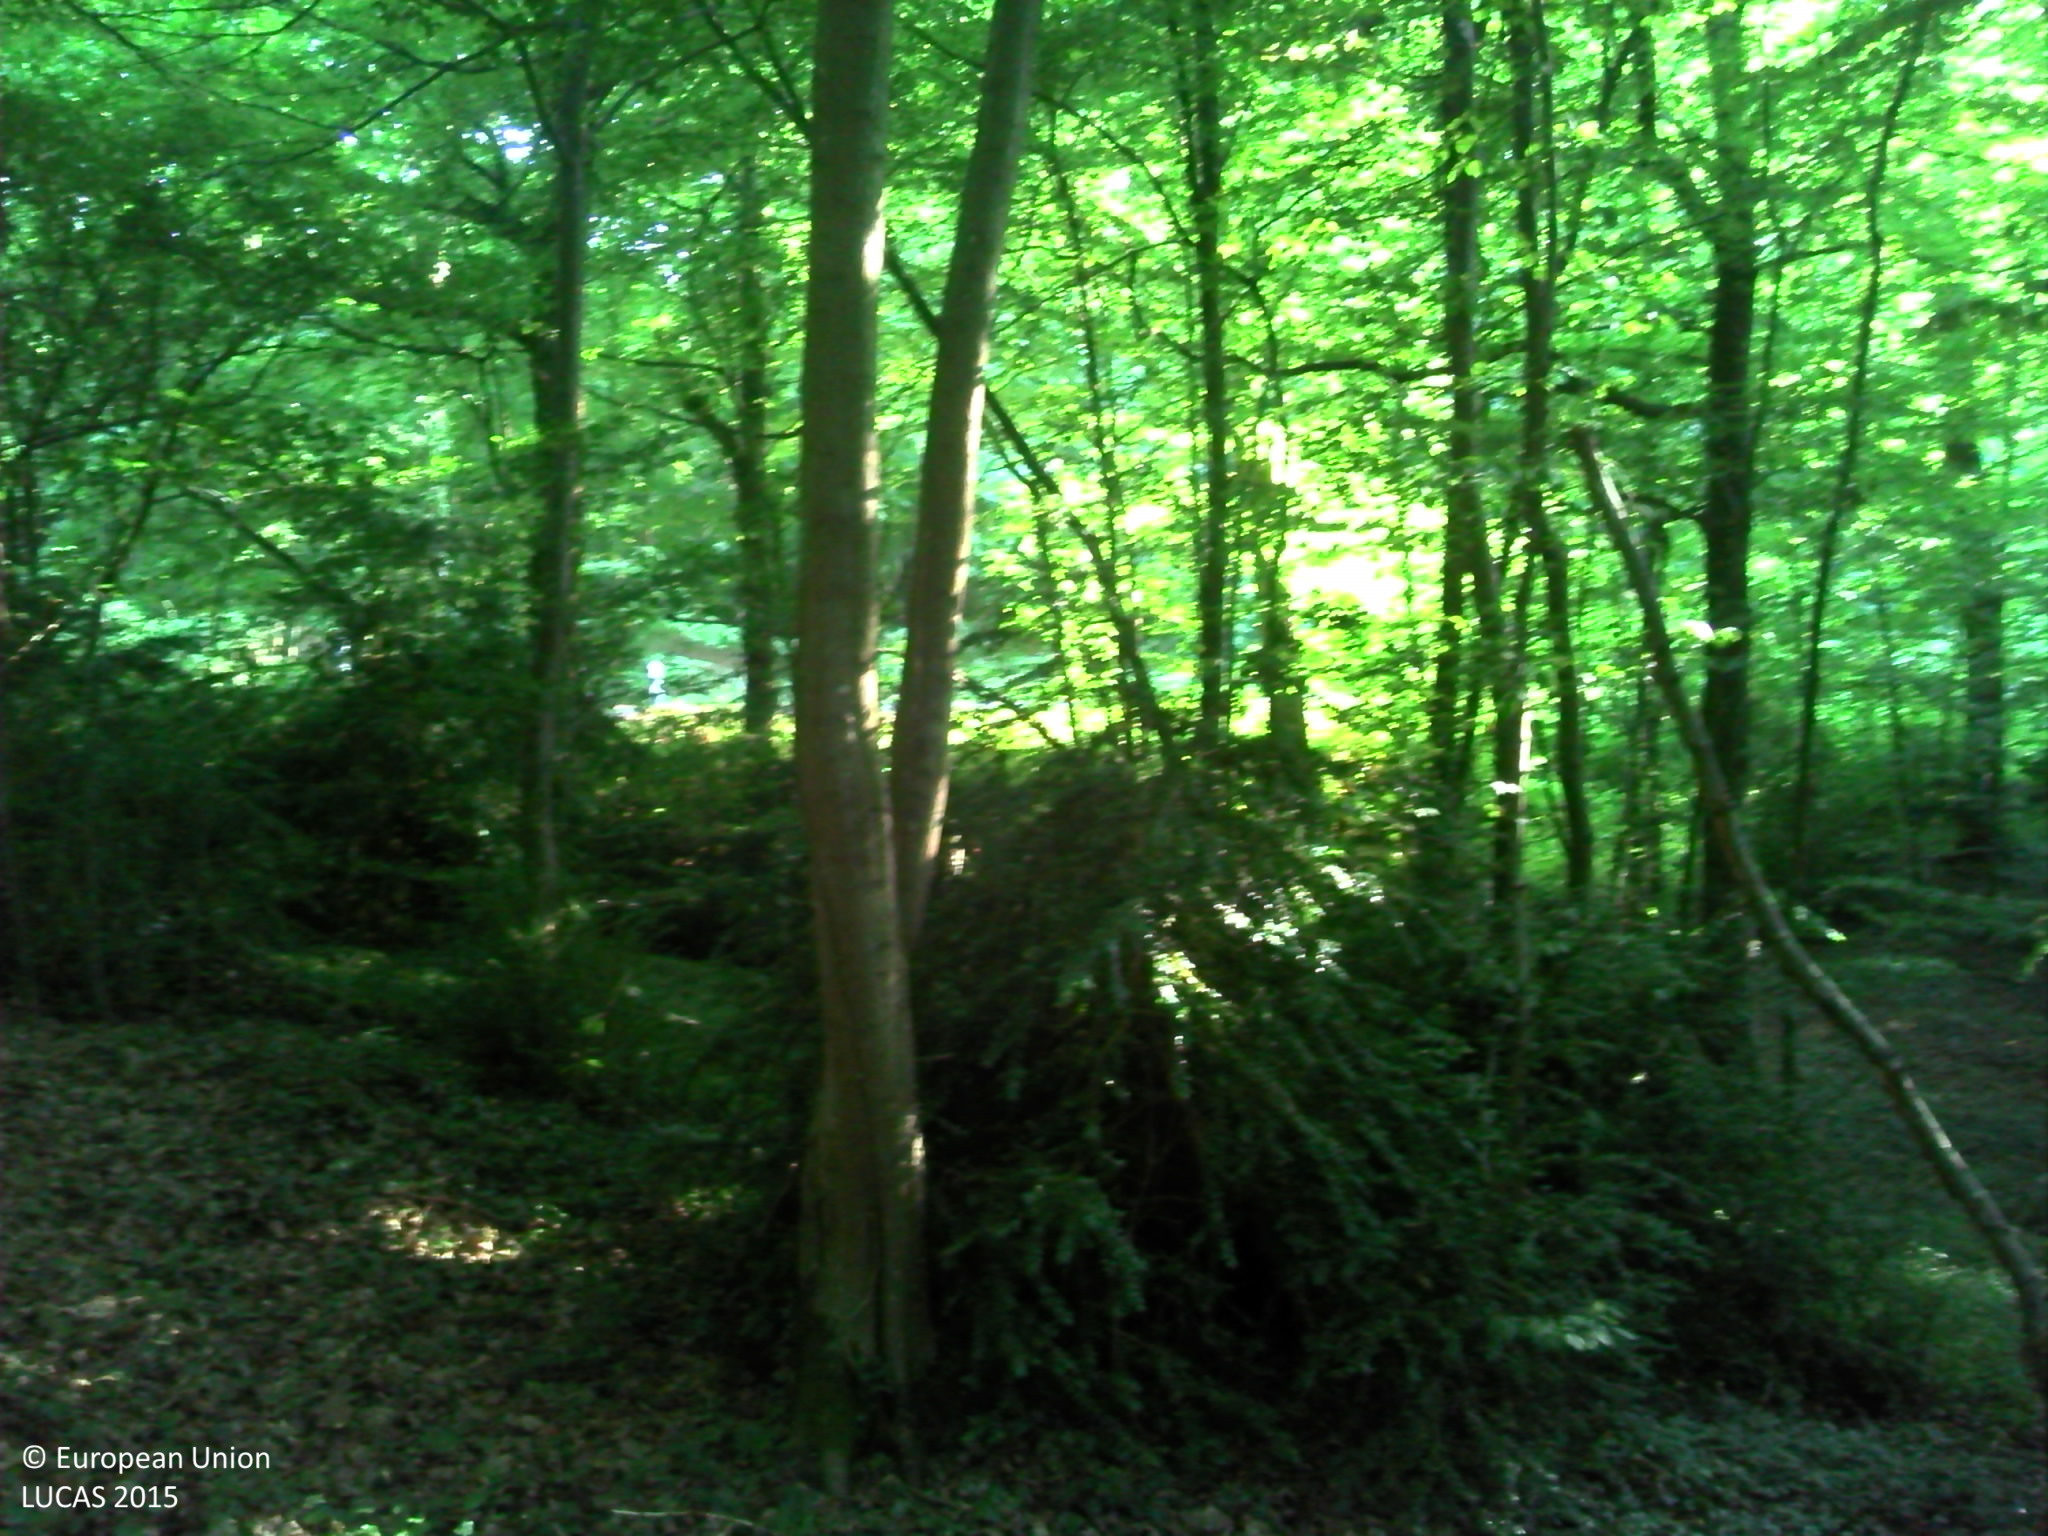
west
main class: Woodland
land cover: Broadleaved woodland
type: mesophytic deciduous forest
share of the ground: > 75 %
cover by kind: broadleaved forest trees 80 %, consolidated bare surface 15 %, herbaceous plants 5 %
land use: Forestry
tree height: > 5 m
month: July
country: FR
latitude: 48.8604
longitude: 1.3531
